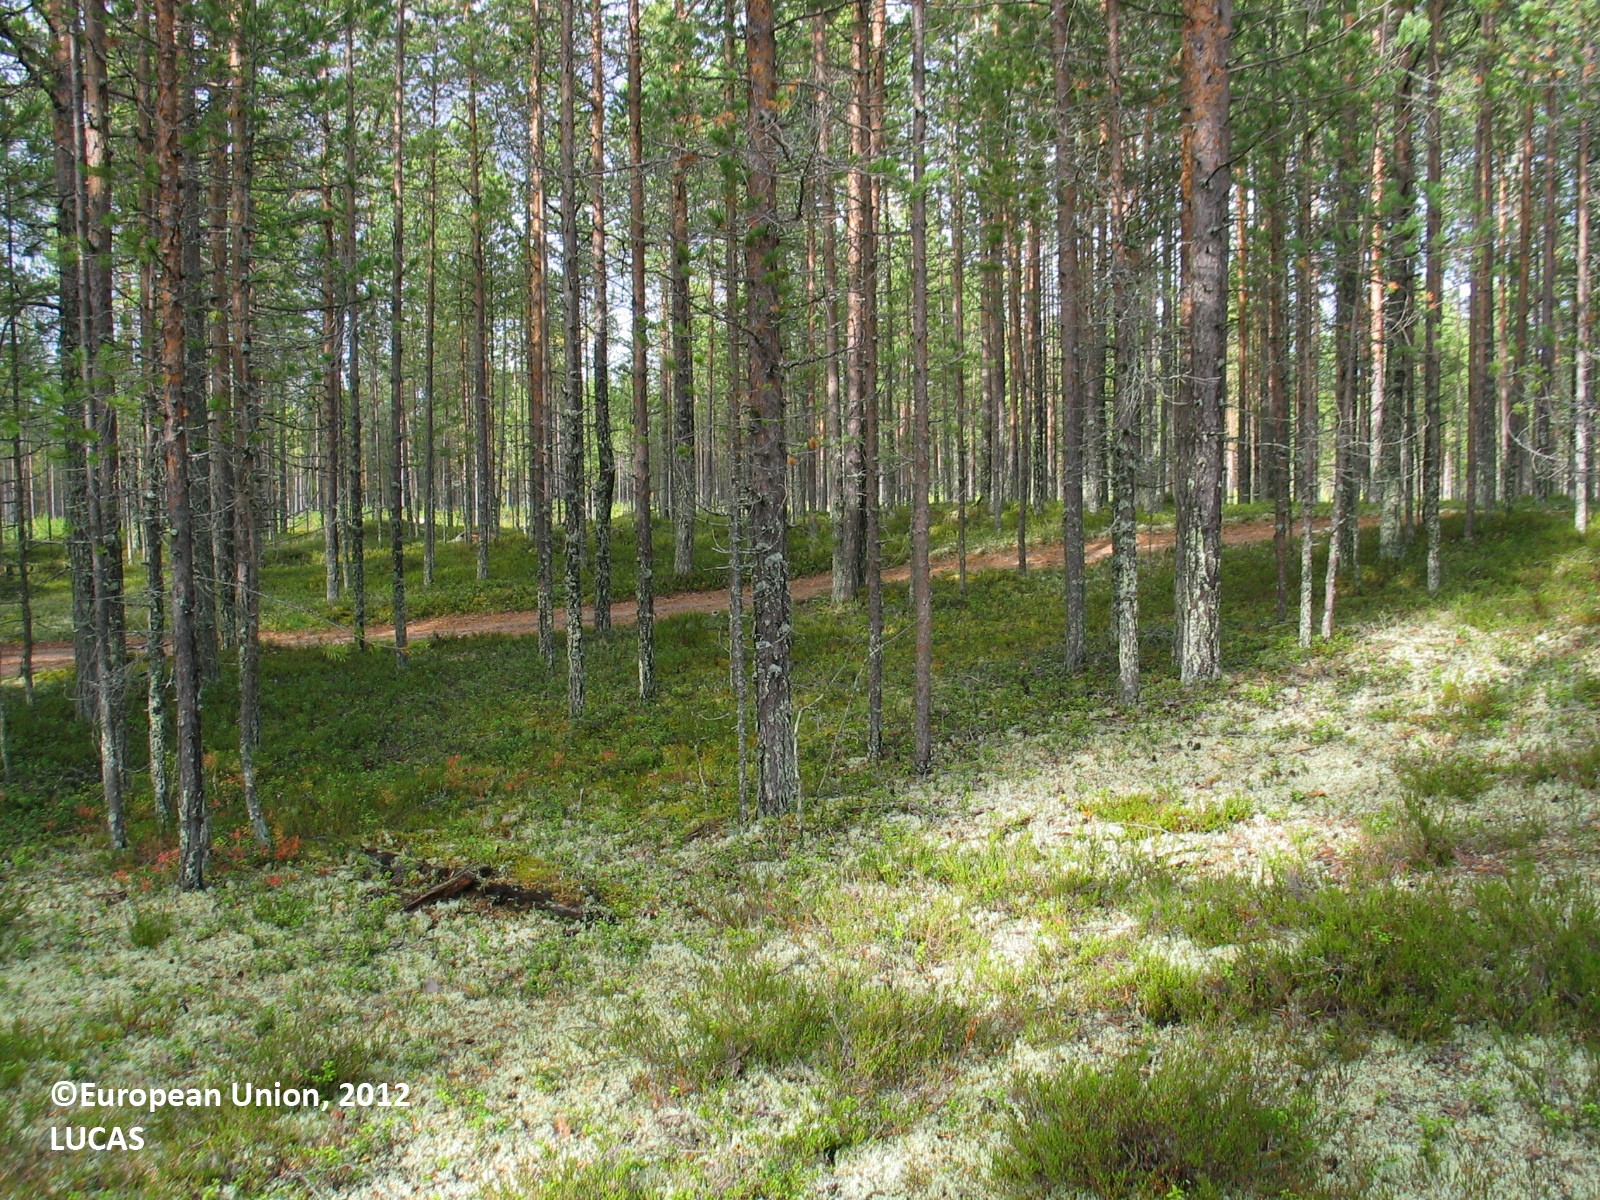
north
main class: Woodland
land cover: Pine dominated coniferous woodland
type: boreal forest
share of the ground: 25 - 50 %
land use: Forestry
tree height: > 5 m
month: September
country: FI
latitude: 65.4175
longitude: 25.5697
